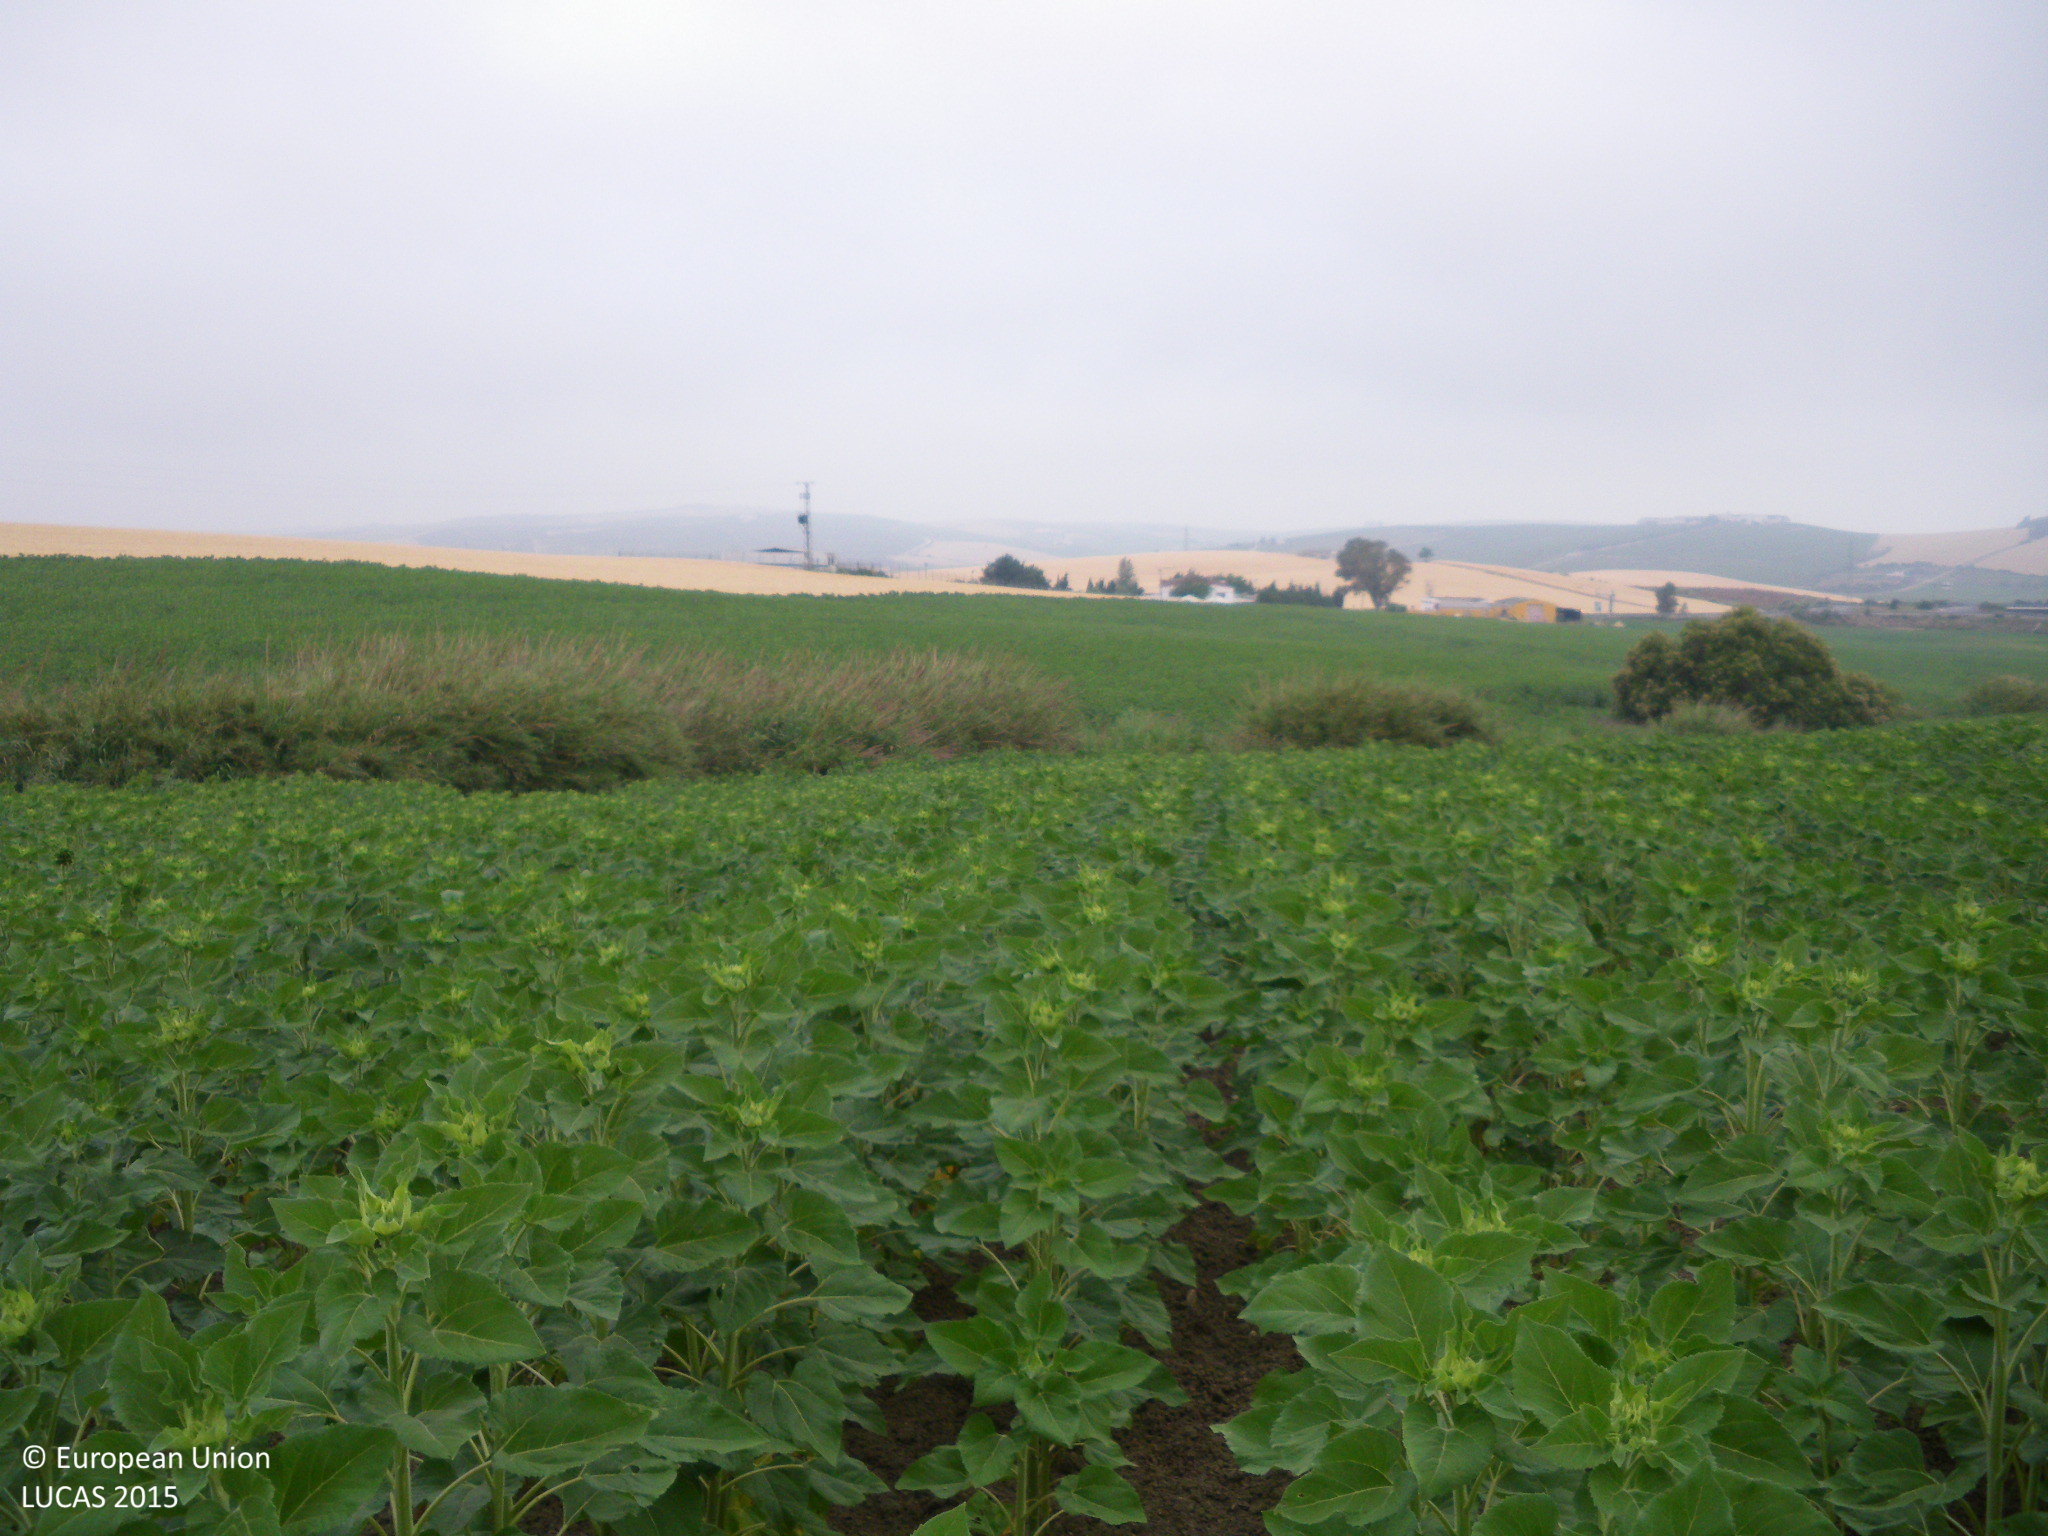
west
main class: Cropland
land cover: Sunflower
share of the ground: > 75 %
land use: Agriculture (excluding fallow land and kitchen gardens)
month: May
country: ES
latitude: 36.7088
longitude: -6.1441
